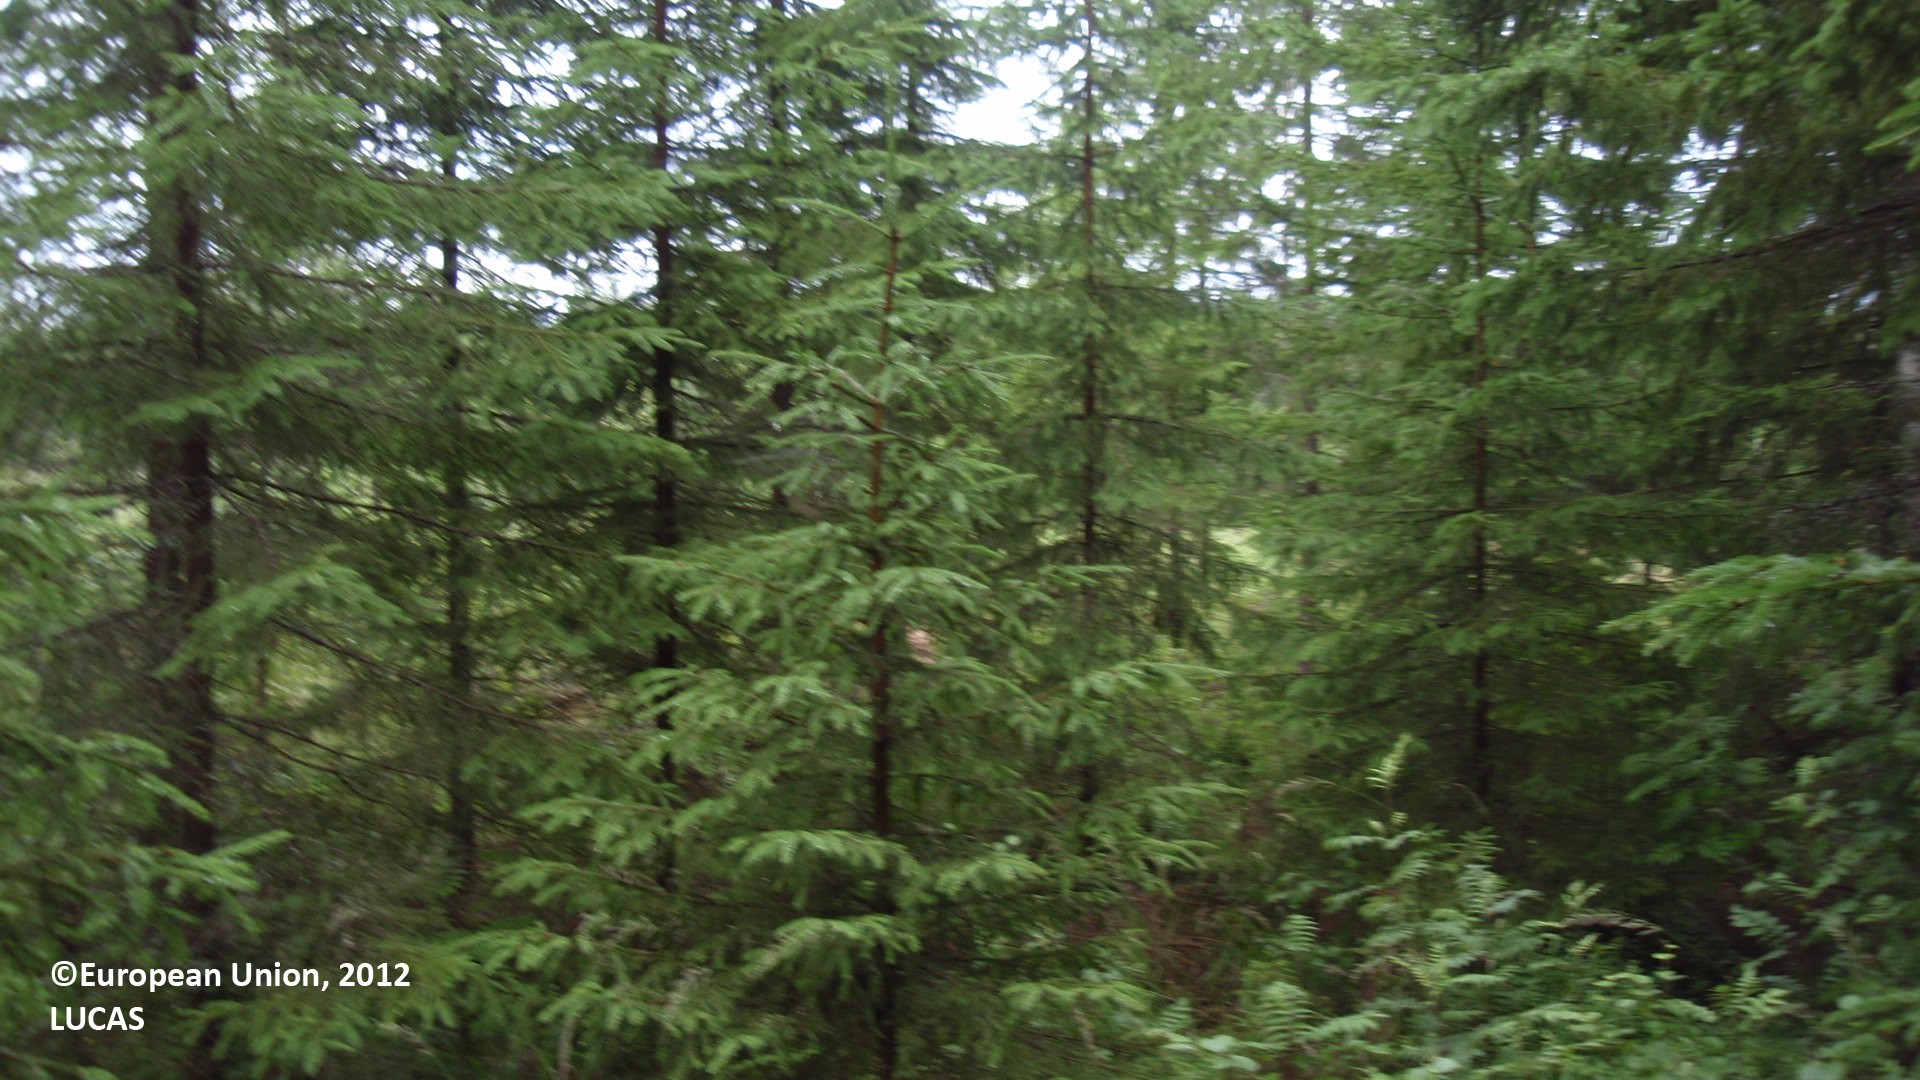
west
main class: Woodland
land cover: Spruce dominated mixed woodland
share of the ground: > 75 %
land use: Forestry
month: July
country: FI
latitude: 61.5852
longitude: 27.2553
